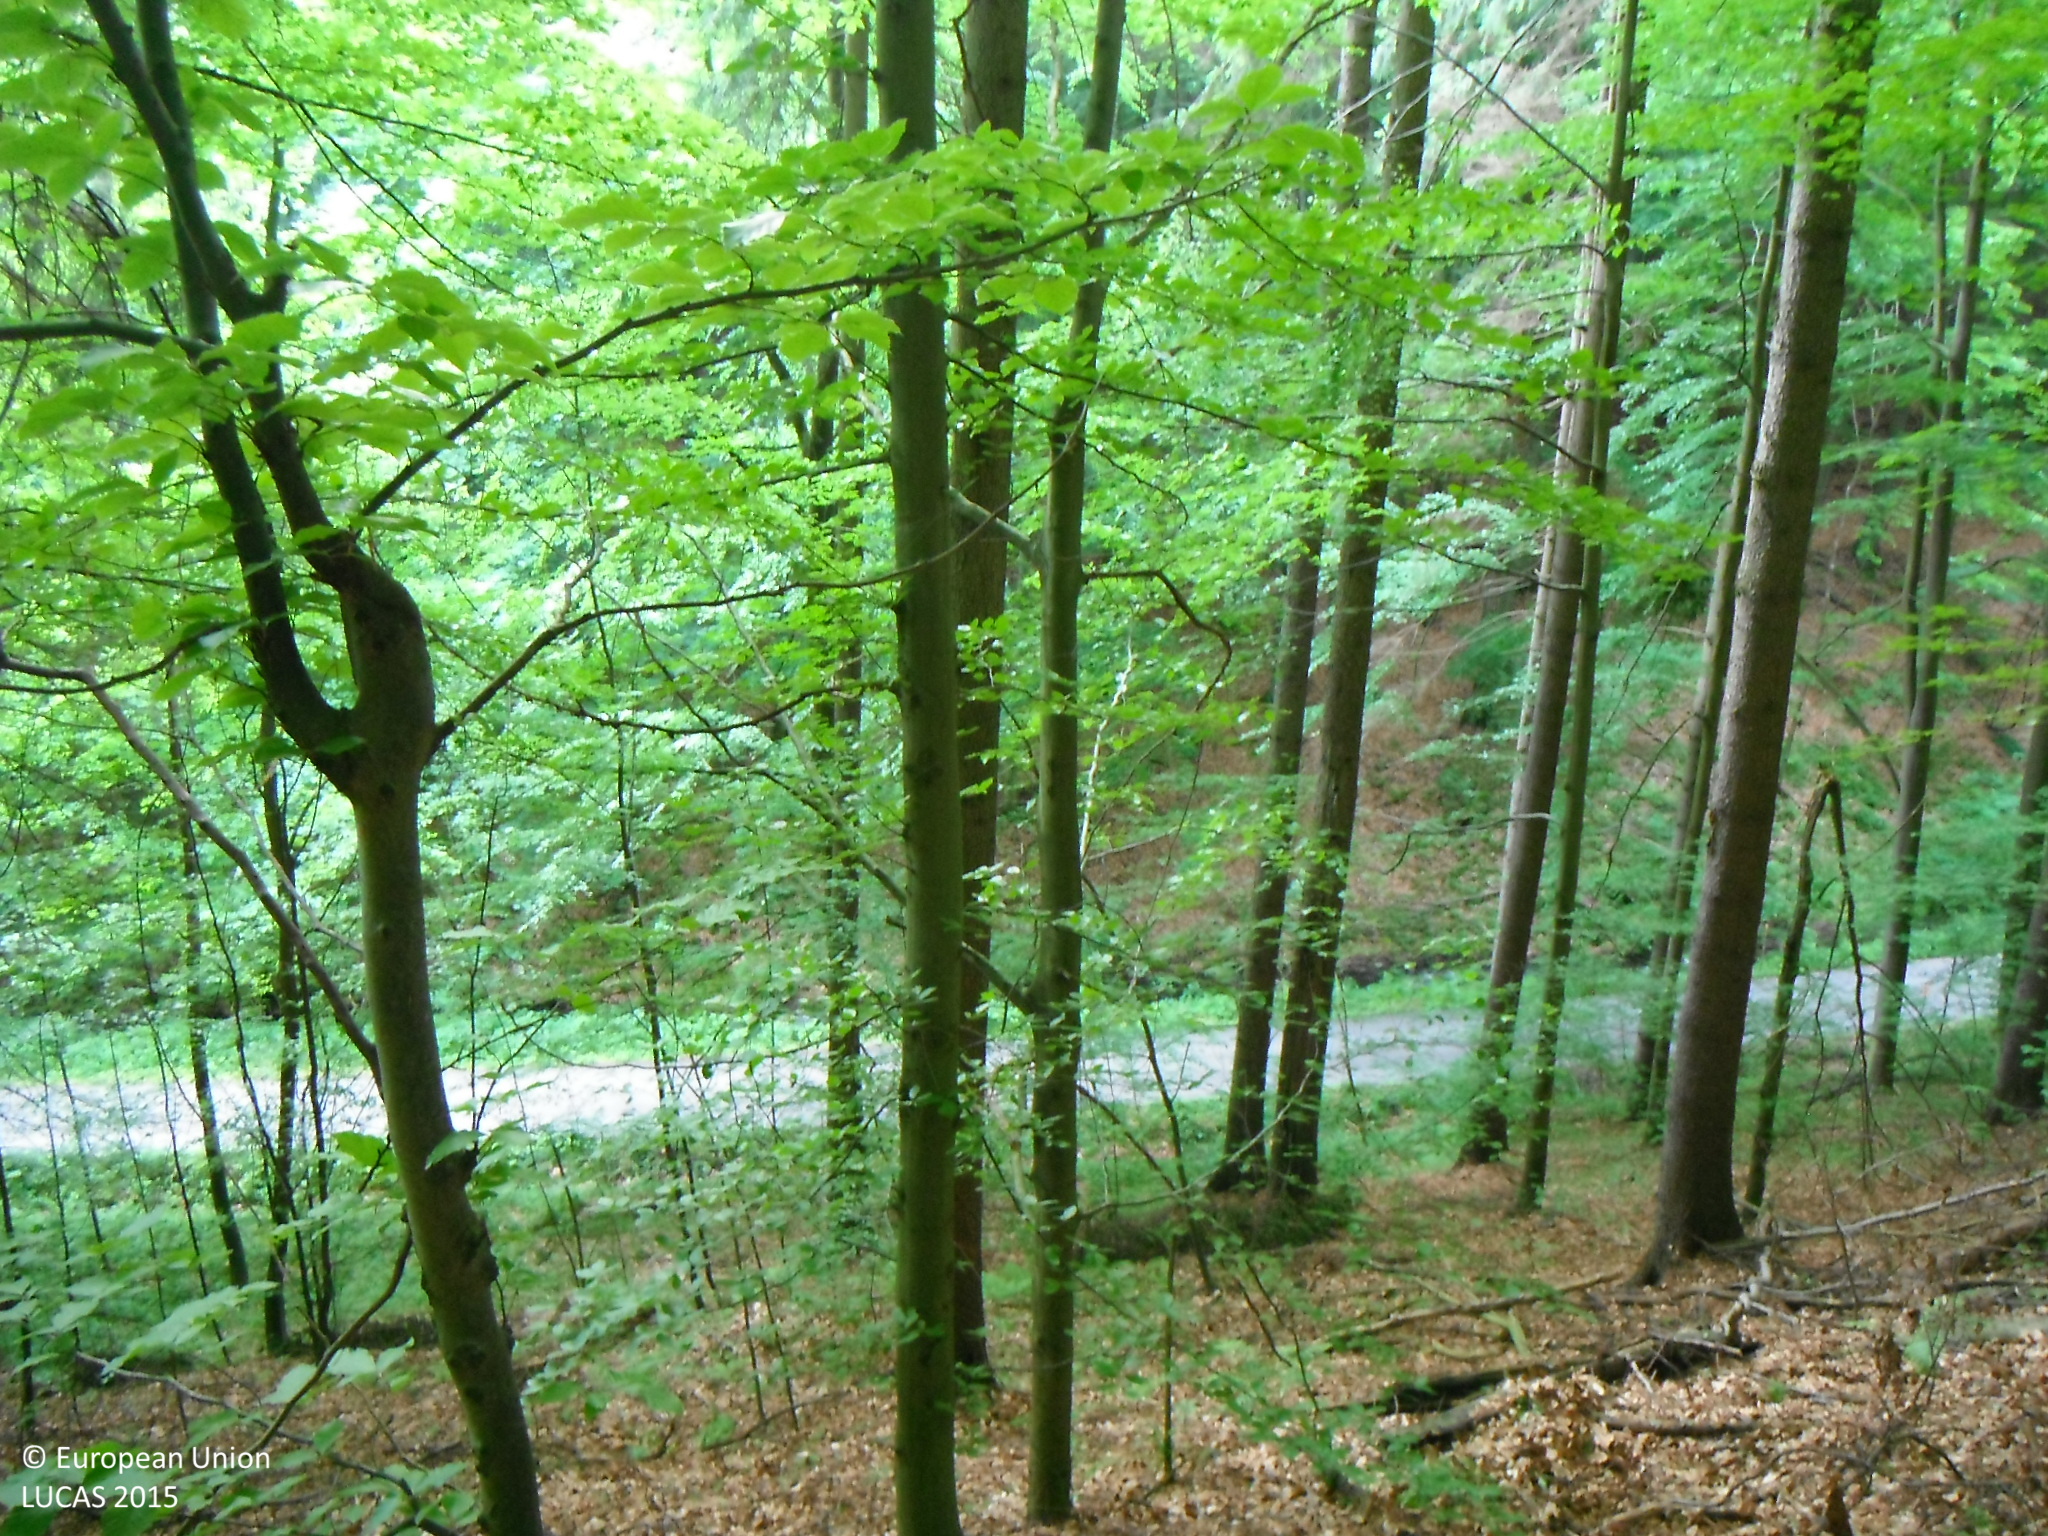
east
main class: Woodland
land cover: Broadleaved woodland
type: beech forest
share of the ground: > 75 %
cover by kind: broadleaved forest trees 100 %
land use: Forestry
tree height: > 5 m
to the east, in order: Broadleaved woodland; Tracks; Grass margins; Rivers and streams; Broadleaved woodland; Spruce dominated coniferous woodland; Broadleaved woodland
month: June
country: SK
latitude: 48.4825
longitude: 19.2903
